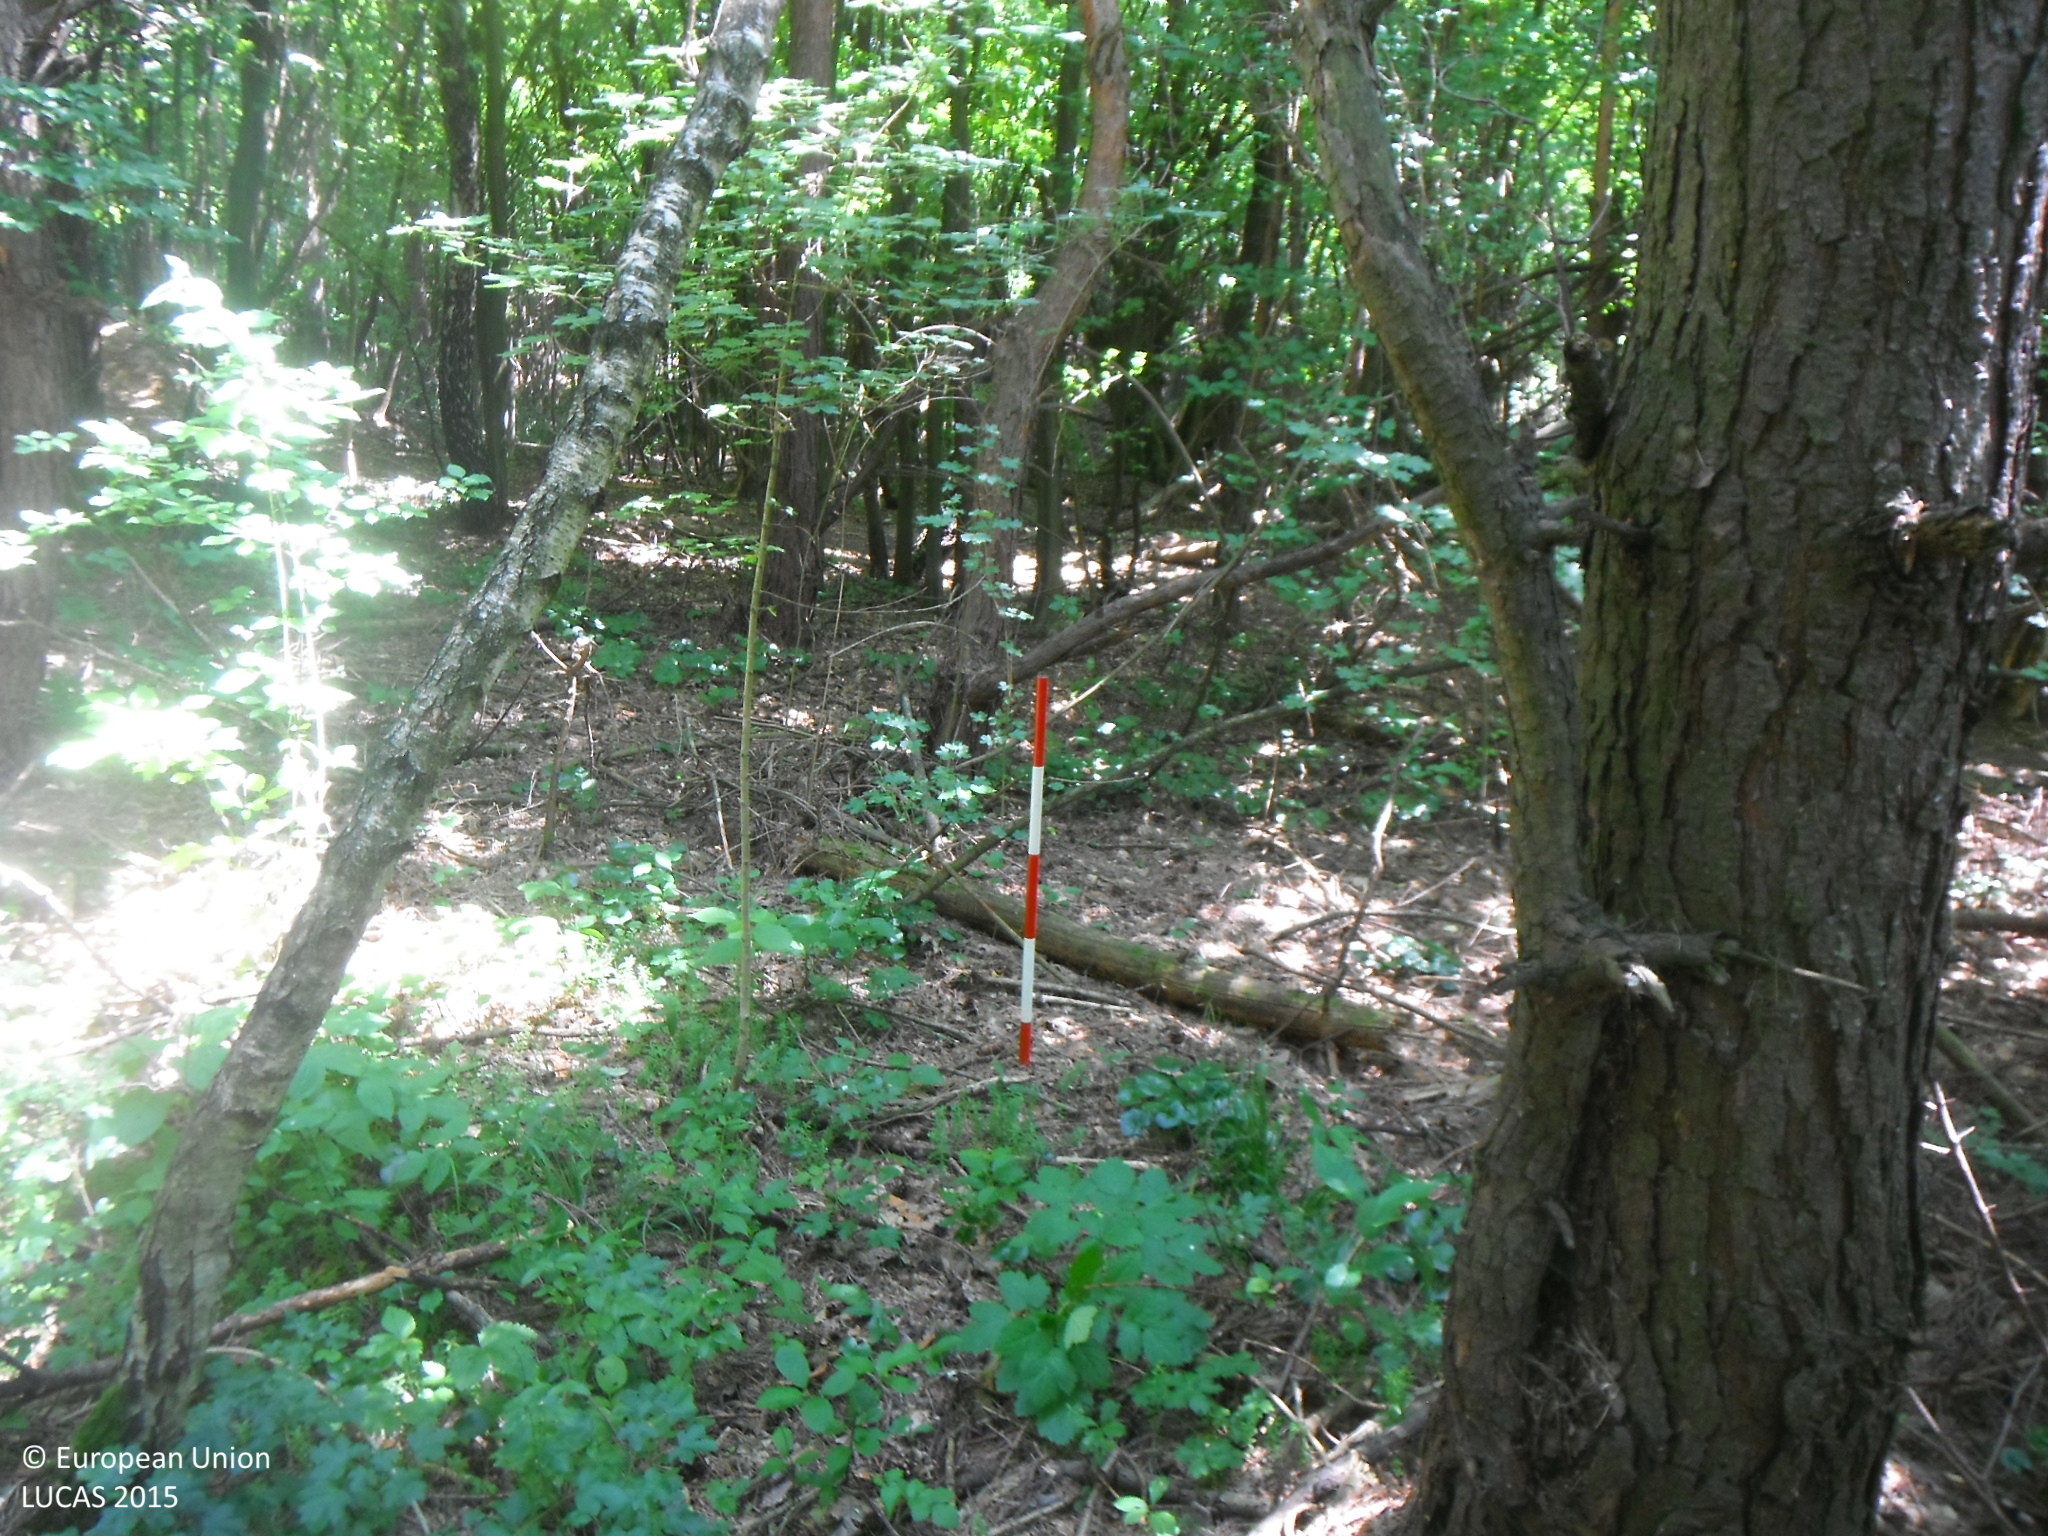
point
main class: Woodland
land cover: Pine dominated mixed woodland
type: beech forest
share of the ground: > 75 %
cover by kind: broadleaved forest trees 70 %, coniferous forest trees 30 %
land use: Forestry
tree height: > 5 m
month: June
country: SK
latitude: 49.0081
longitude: 21.6019
